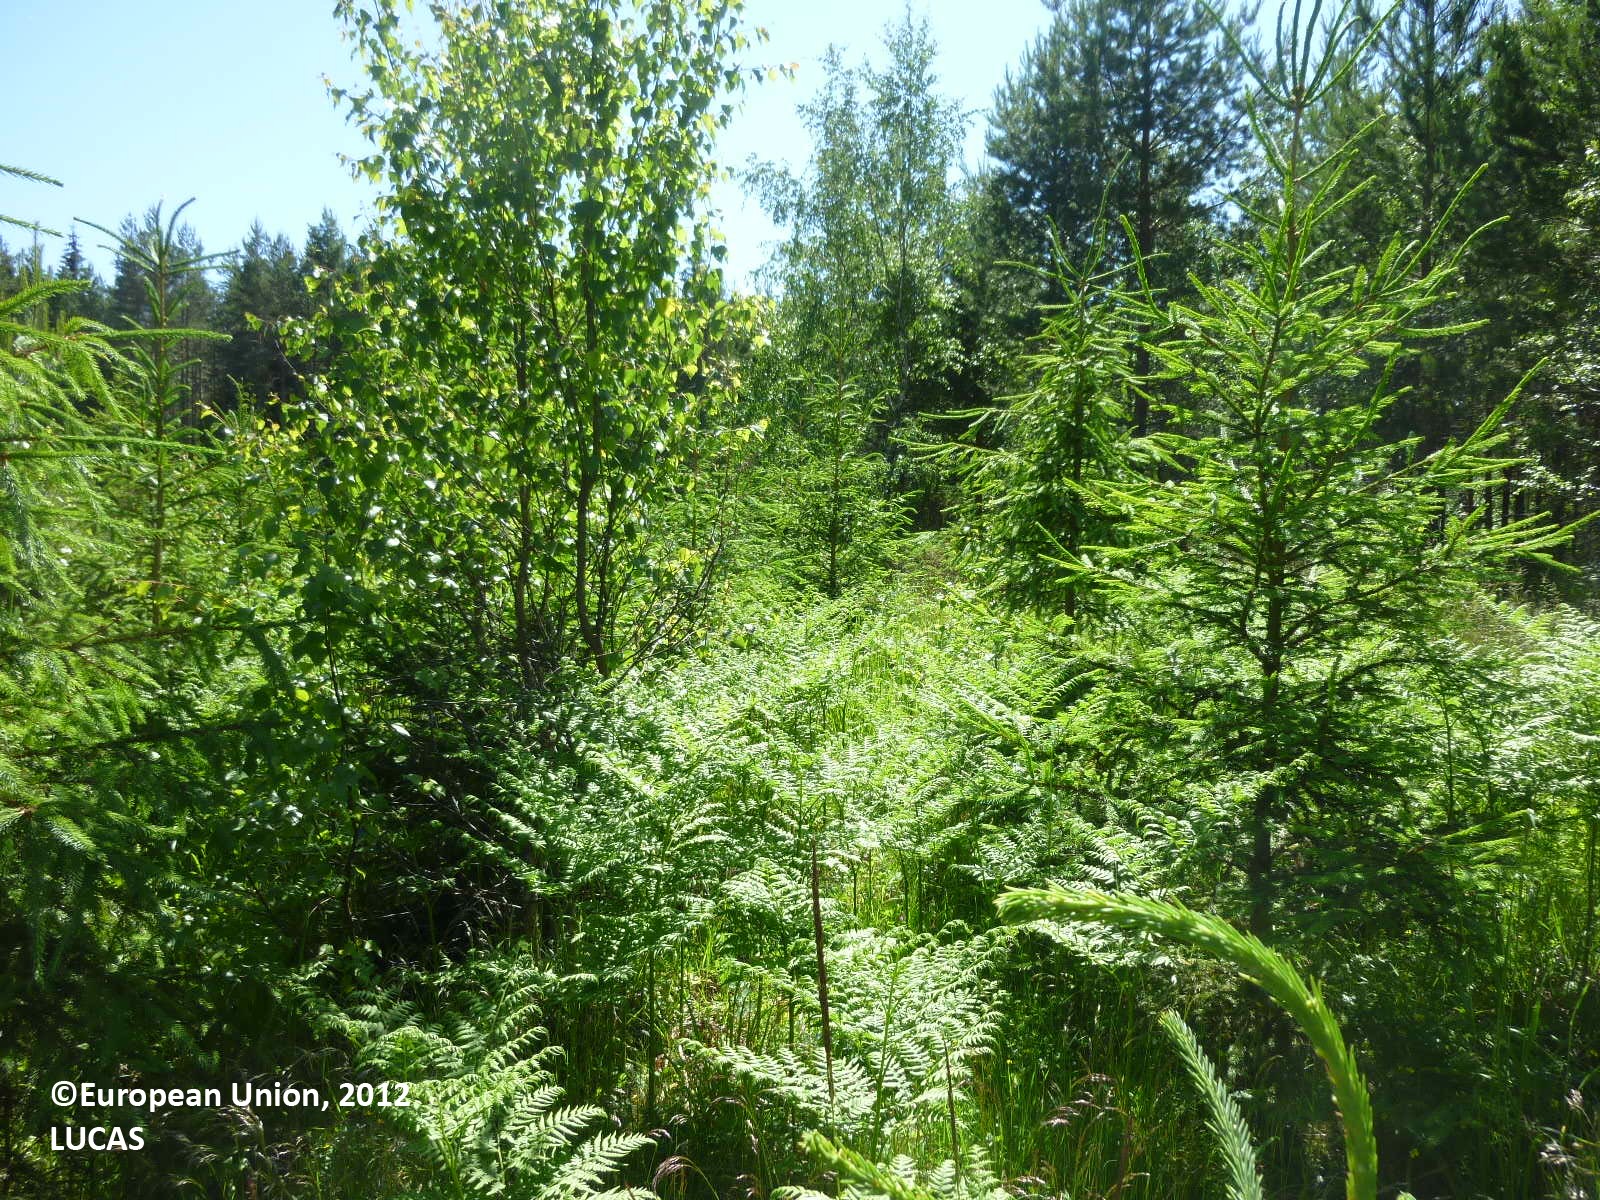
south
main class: Woodland
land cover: Spruce dominated coniferous woodland
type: boreal forest
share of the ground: < 10 %
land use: Forestry
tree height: > 5 m
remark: Clear cut
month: June
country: FI
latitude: 60.1434
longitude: 22.5895
